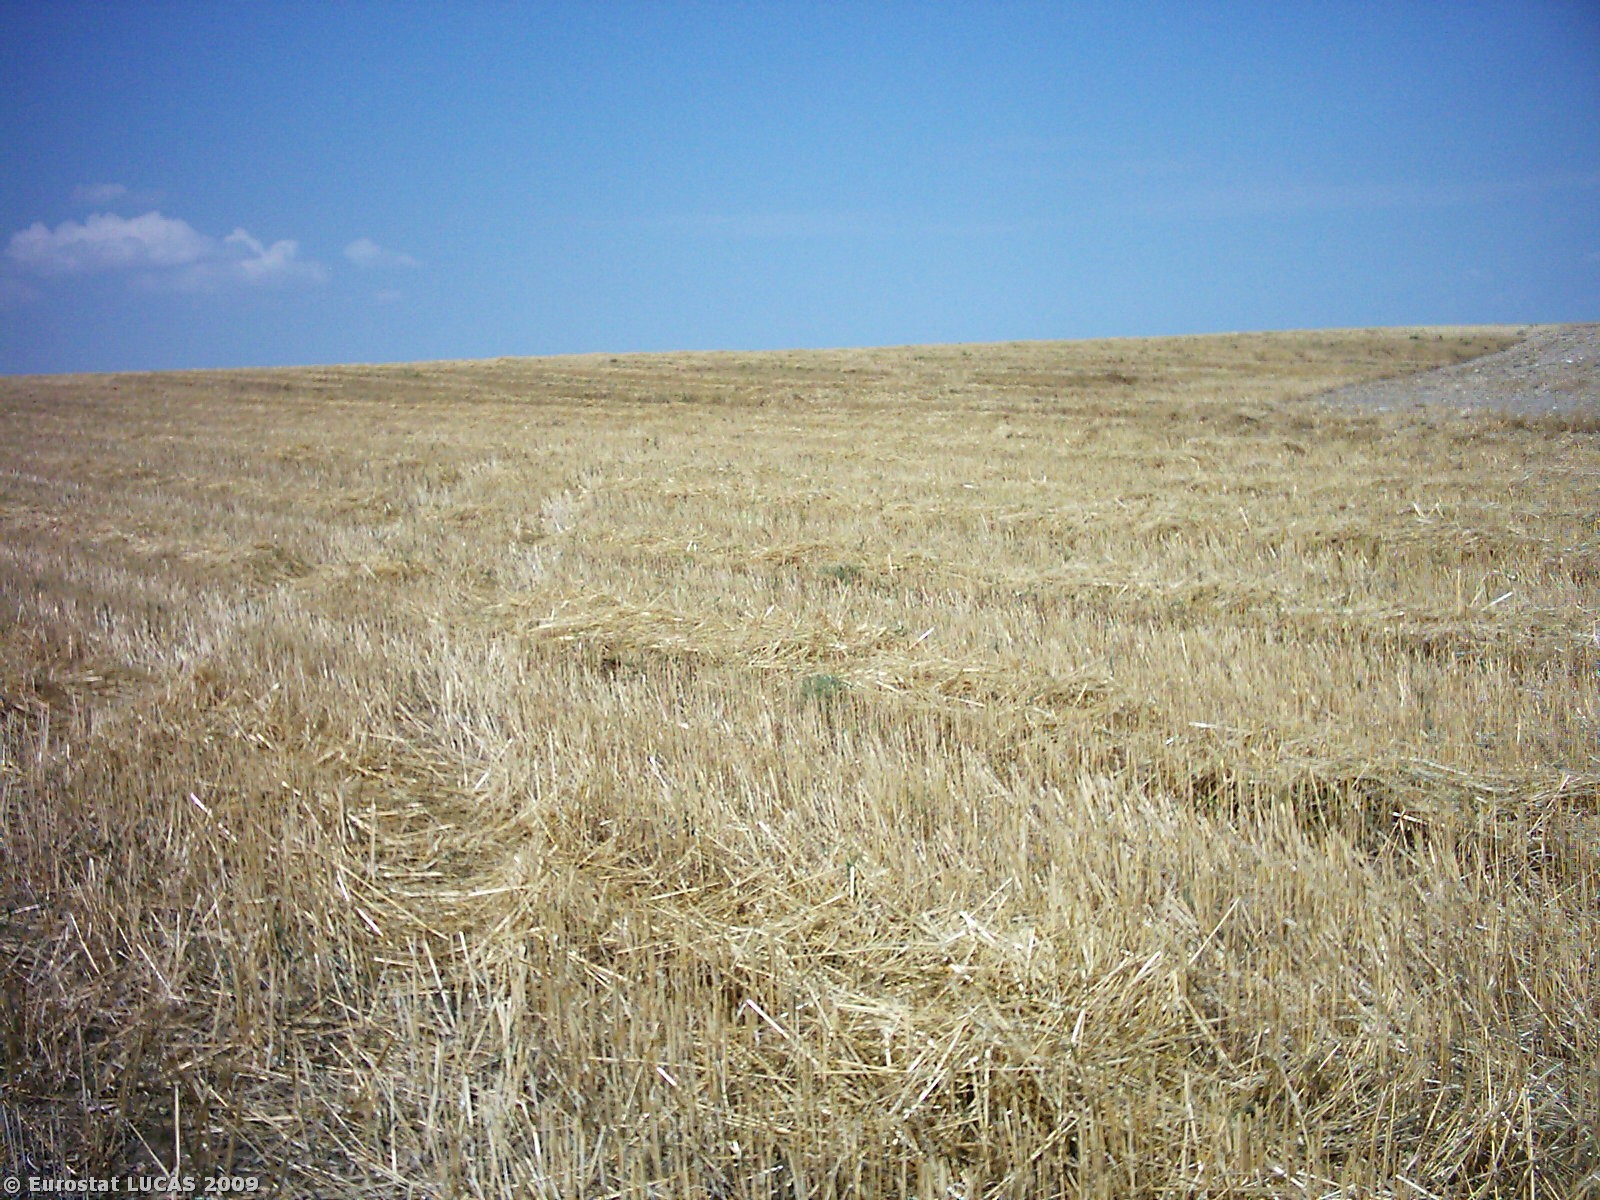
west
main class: Cropland
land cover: Durum wheat
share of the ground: < 10 %
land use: Agriculture (excluding fallow land and kitchen gardens)
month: July
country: IT
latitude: 41.2634
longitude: 15.6744
